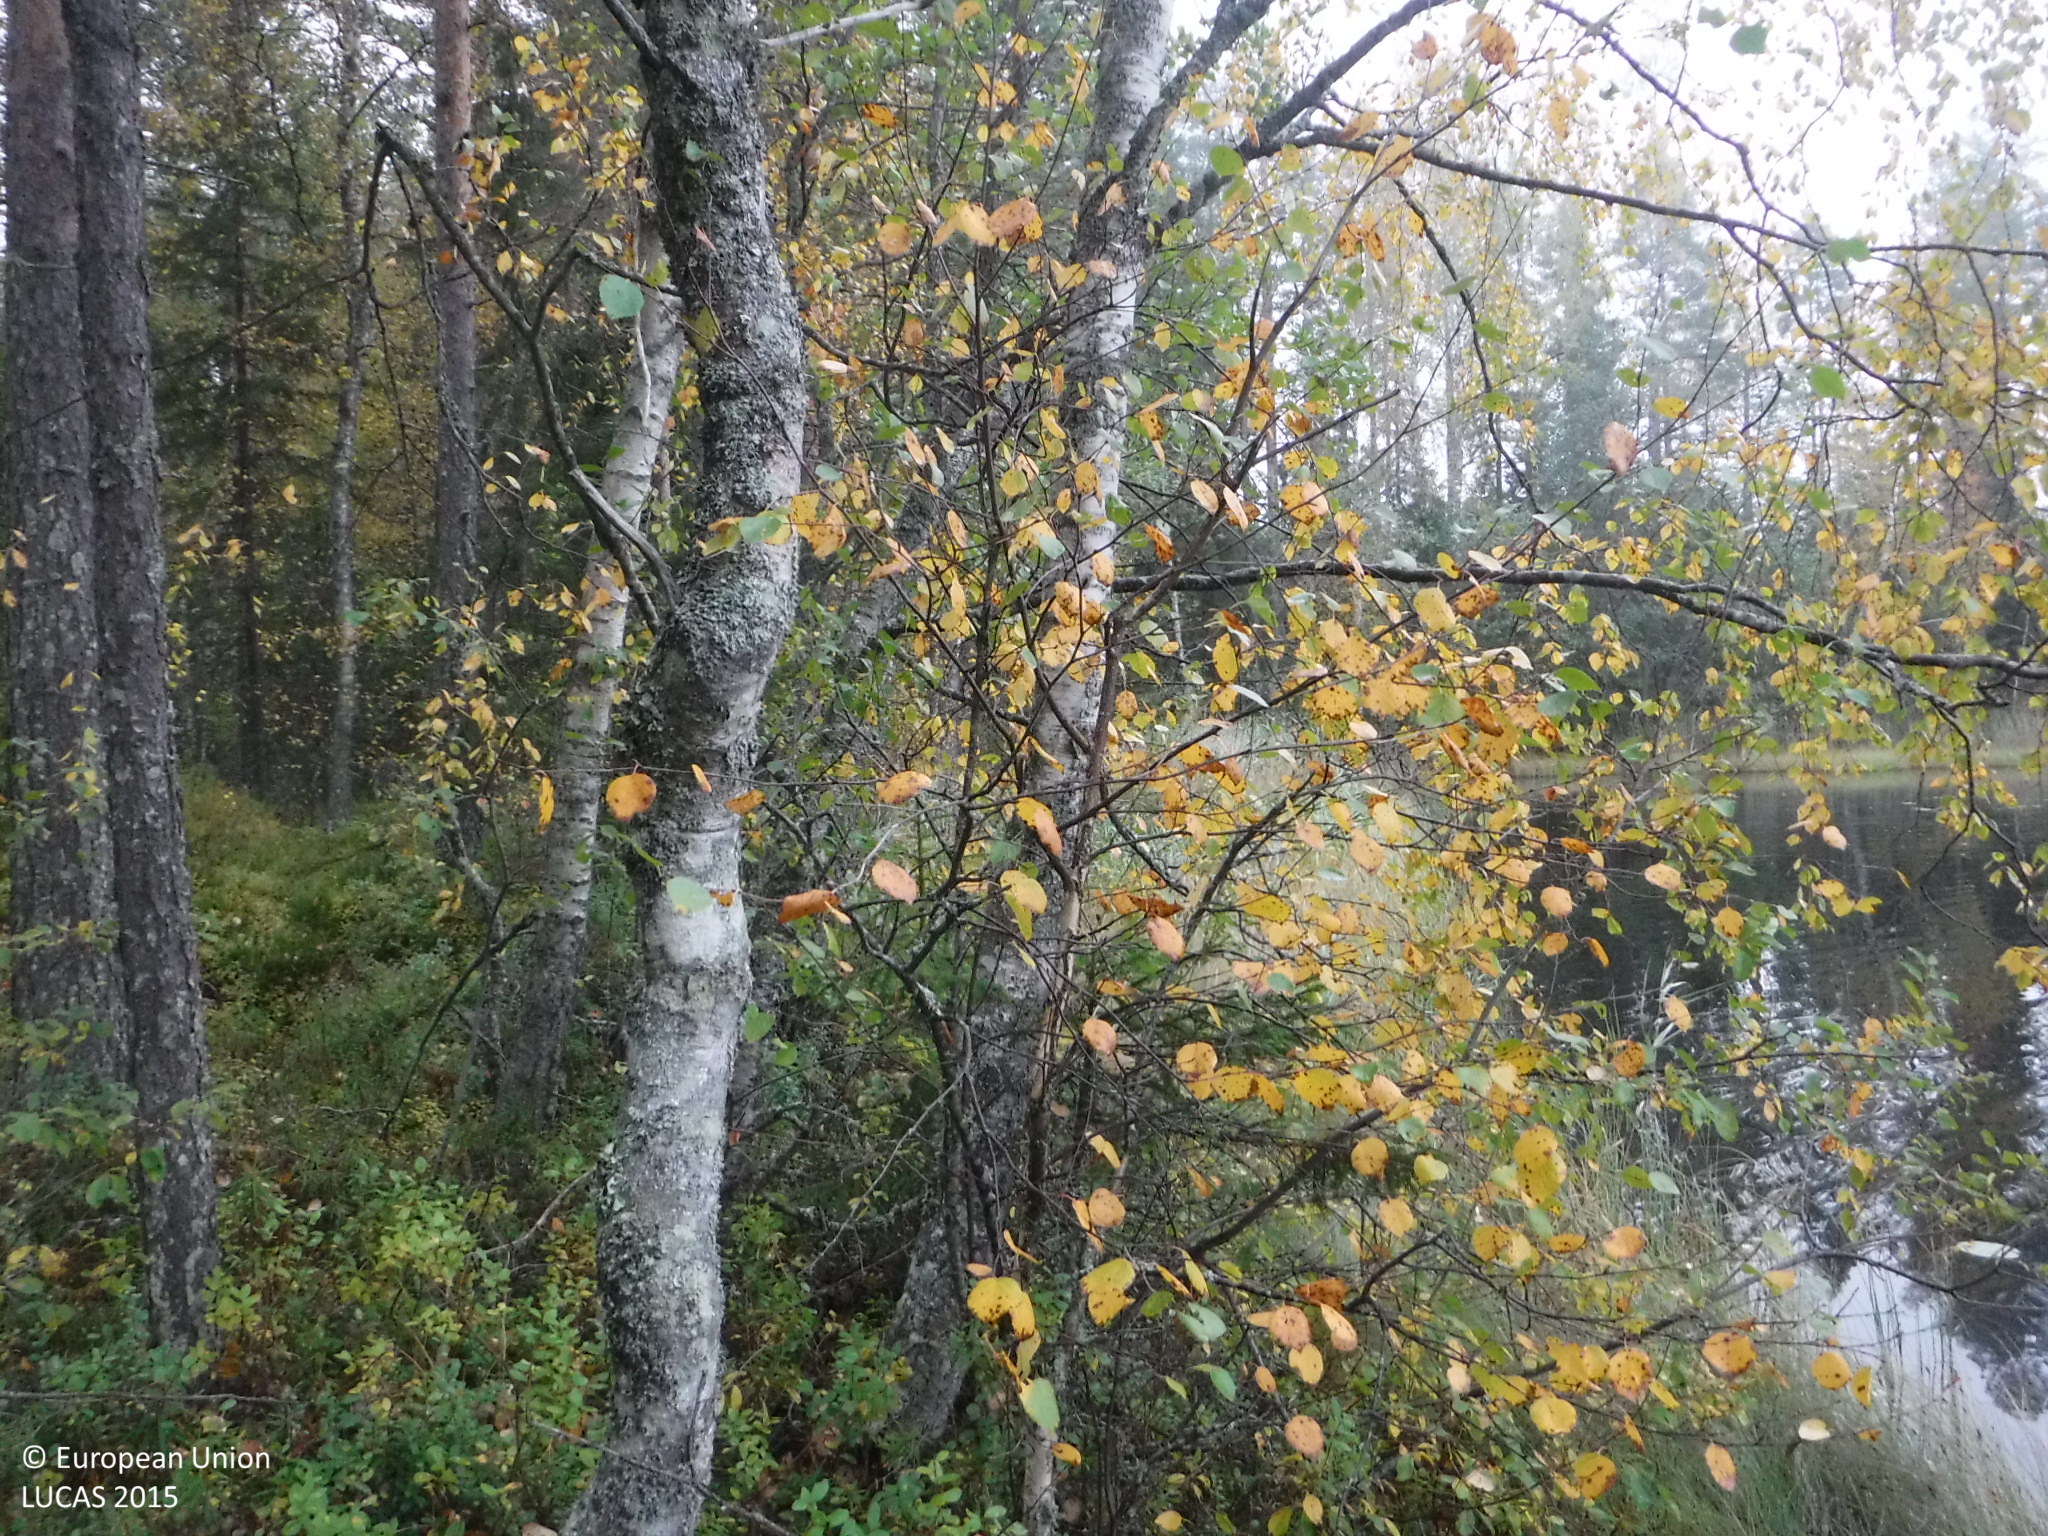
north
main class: Woodland
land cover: Other coniferous woodland
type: boreal forest
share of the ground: 50 - 75 %
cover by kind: coniferous forest trees 60 %, shrubs 30 %, broadleaved forest trees 5 %, lichens and mosses 5 %
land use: Forestry
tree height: > 5 m
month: September
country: FI
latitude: 61.8036
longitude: 24.2244
